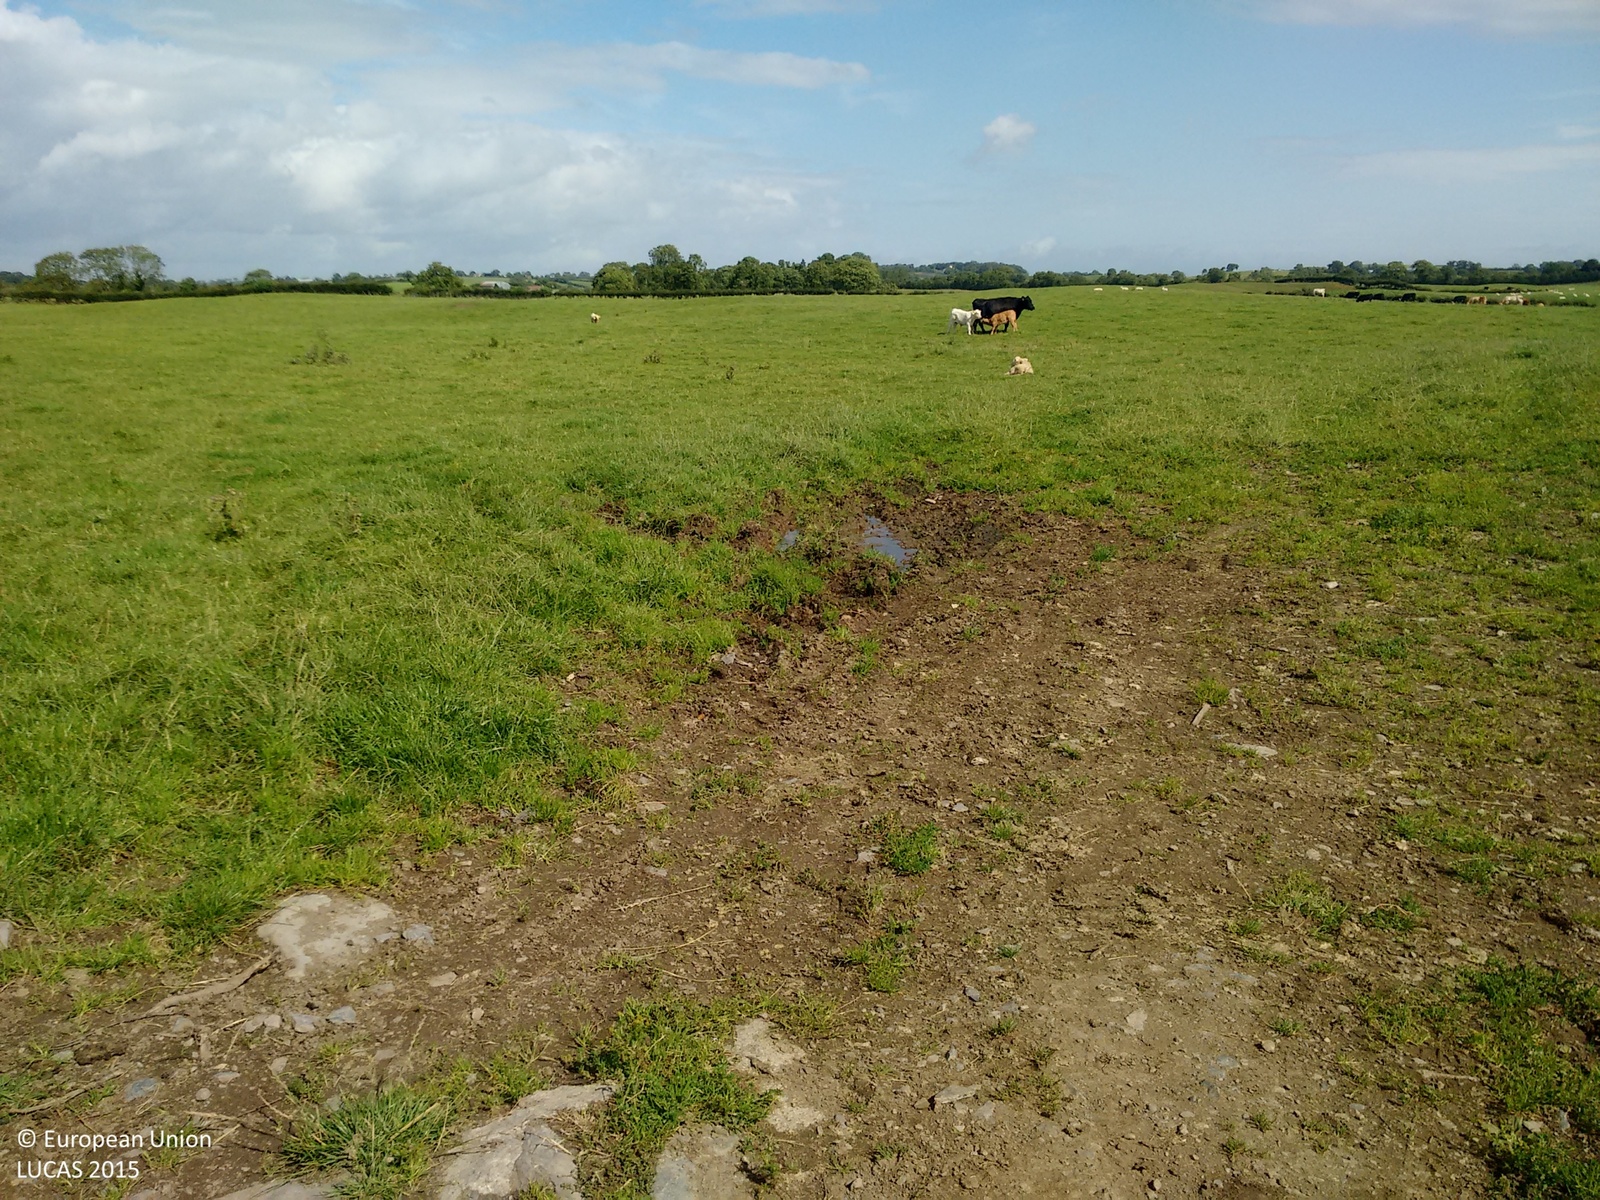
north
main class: Grassland
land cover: Grassland without tree/shrub cover
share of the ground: > 75 %
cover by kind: herbaceous plants 100 %
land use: Agriculture (excluding fallow land and kitchen gardens)
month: August
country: GB
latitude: 54.4425
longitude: -5.6911
